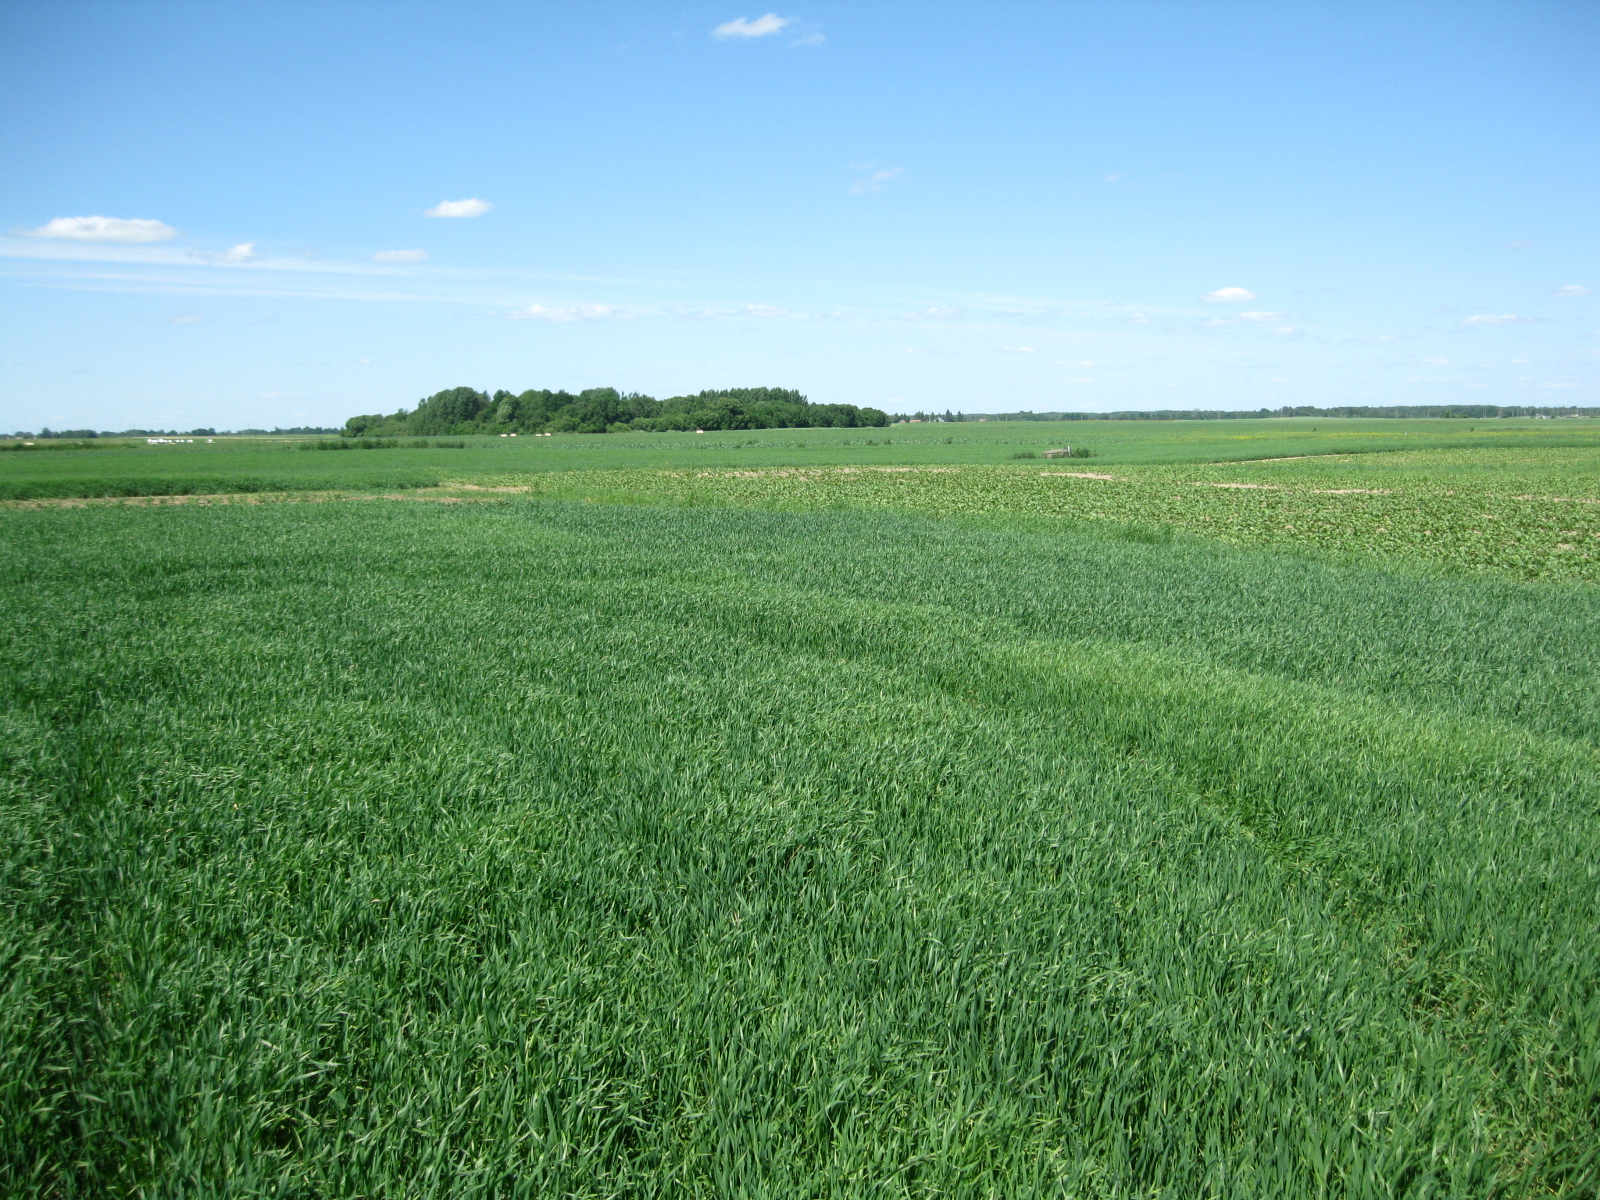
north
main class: Cropland
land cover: Triticale
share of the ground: > 75 %
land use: Agriculture (excluding fallow land and kitchen gardens)
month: June
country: LT
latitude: 55.2771
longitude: 23.9254
